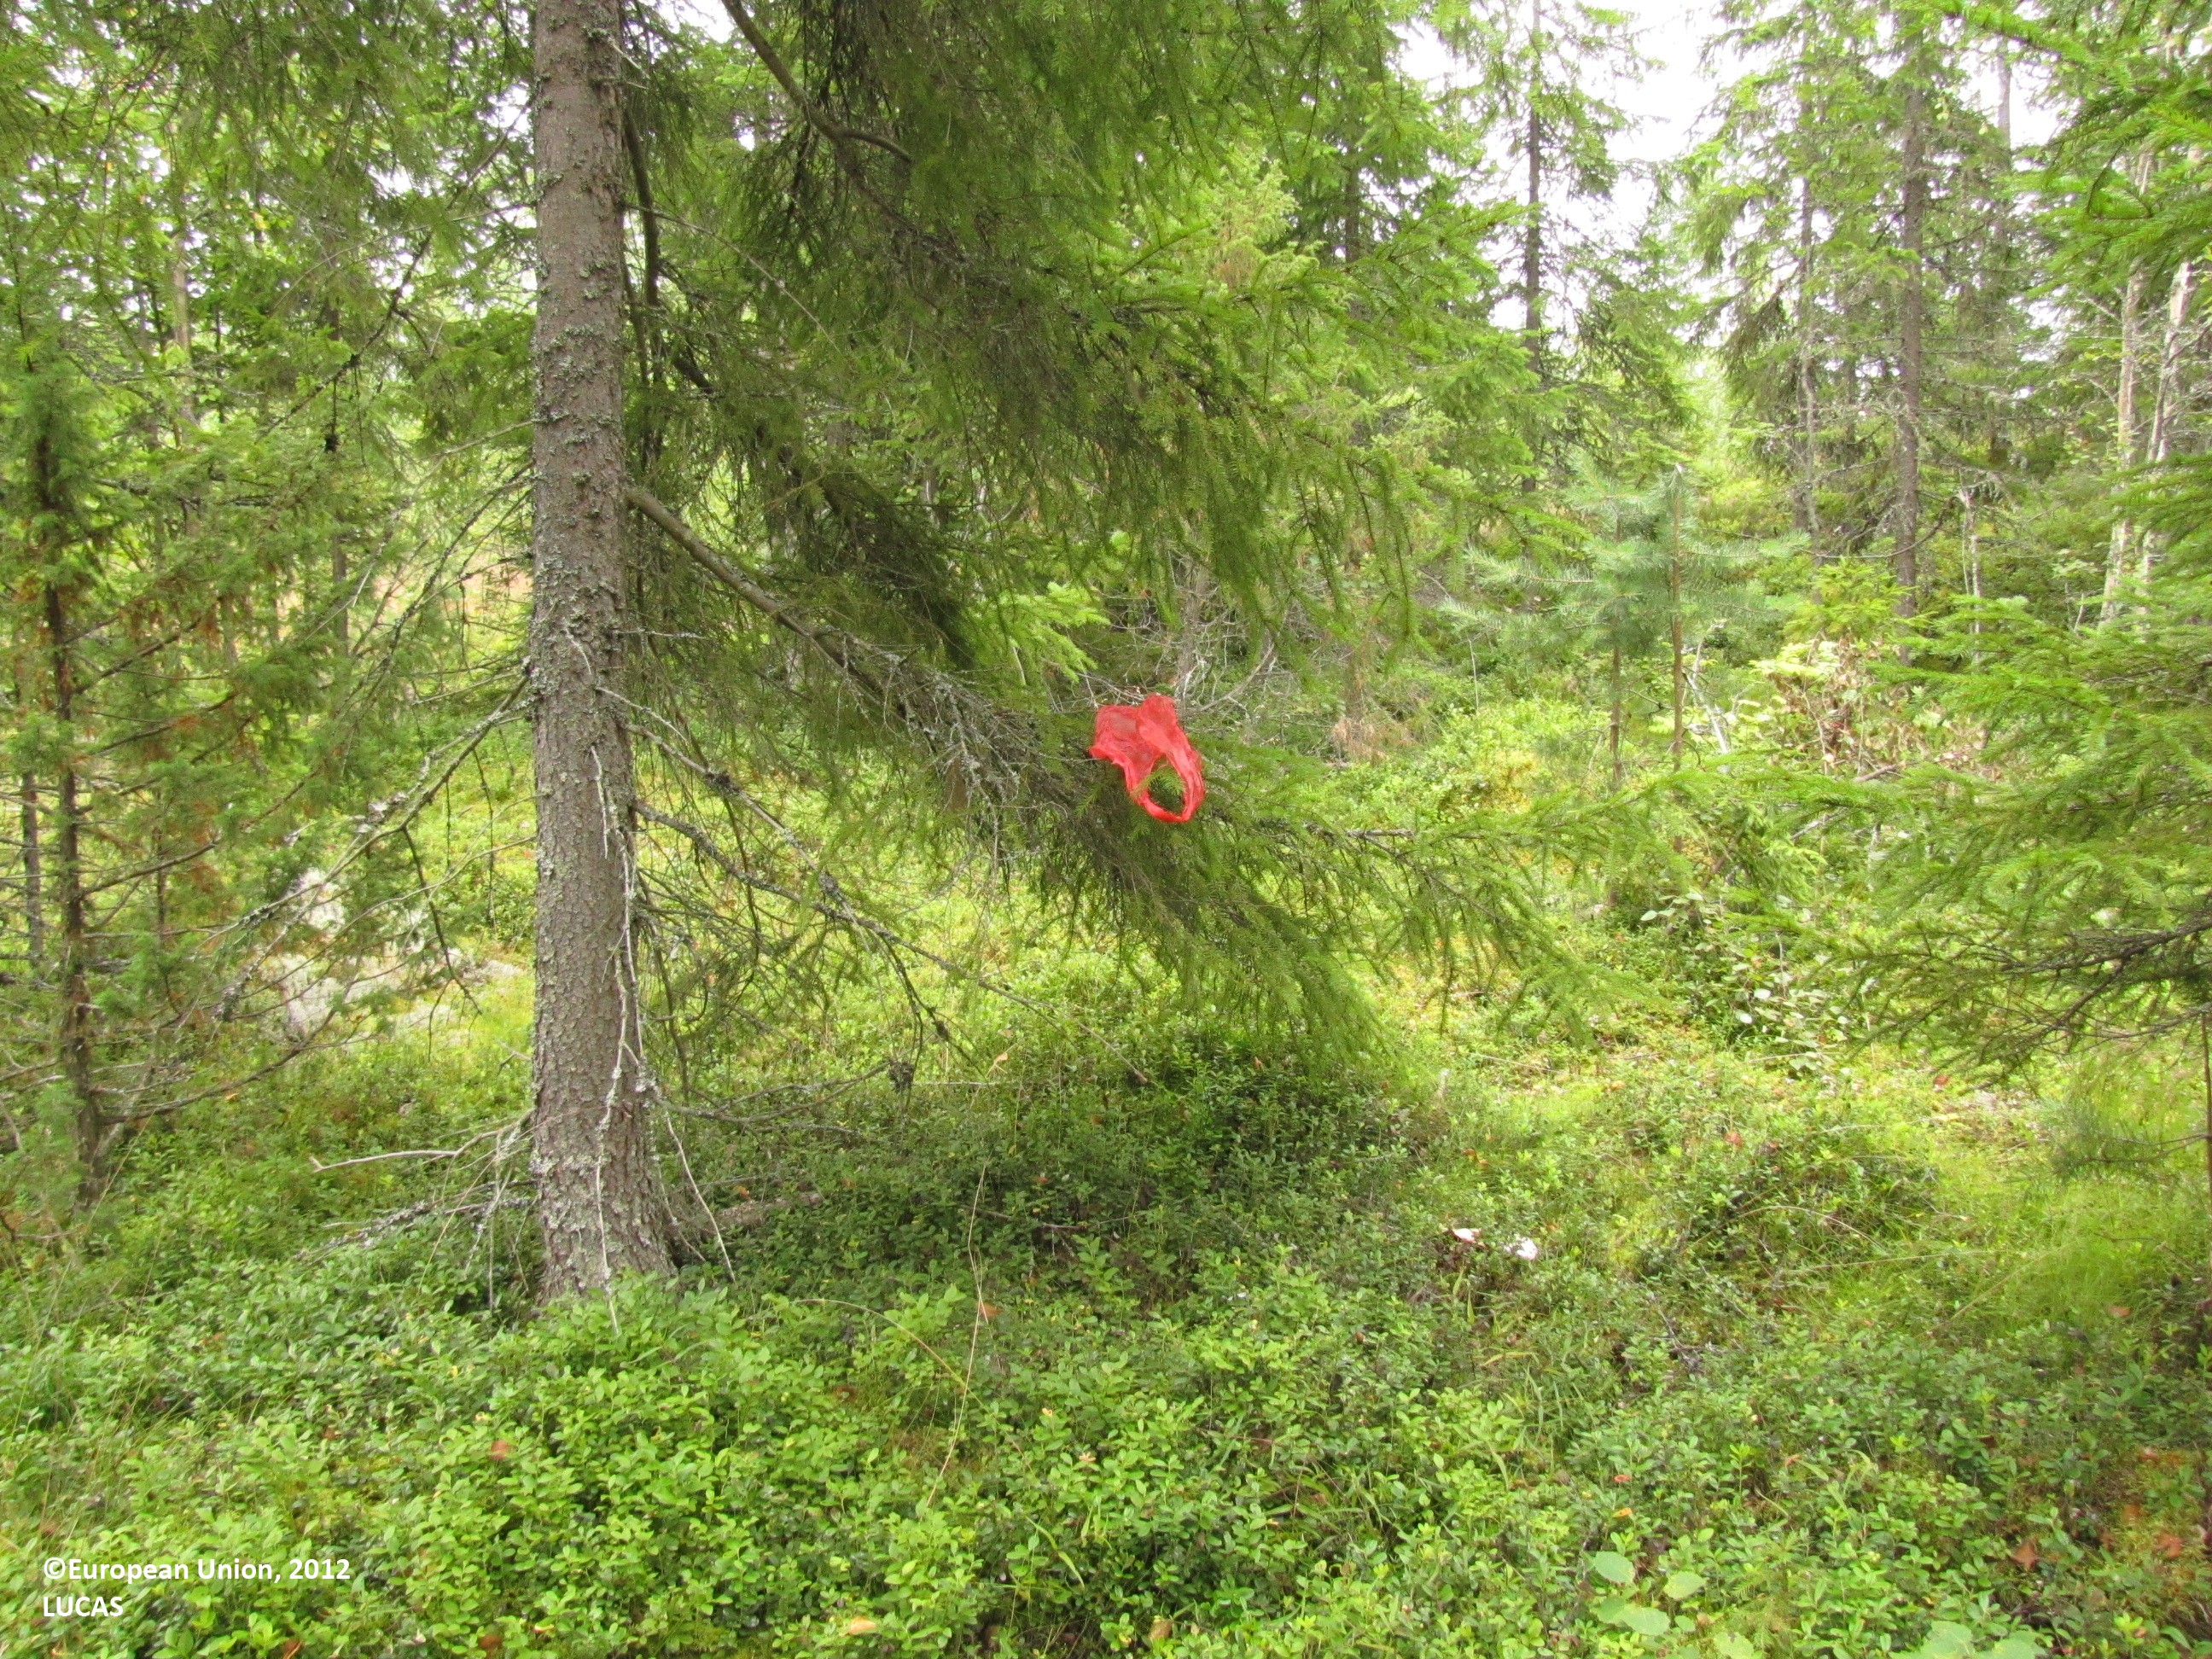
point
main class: Woodland
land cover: Spruce dominated coniferous woodland
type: boreal forest
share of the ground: 50 - 75 %
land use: Forestry
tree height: > 5 m
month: August
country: FI
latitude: 61.9321
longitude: 23.0424
